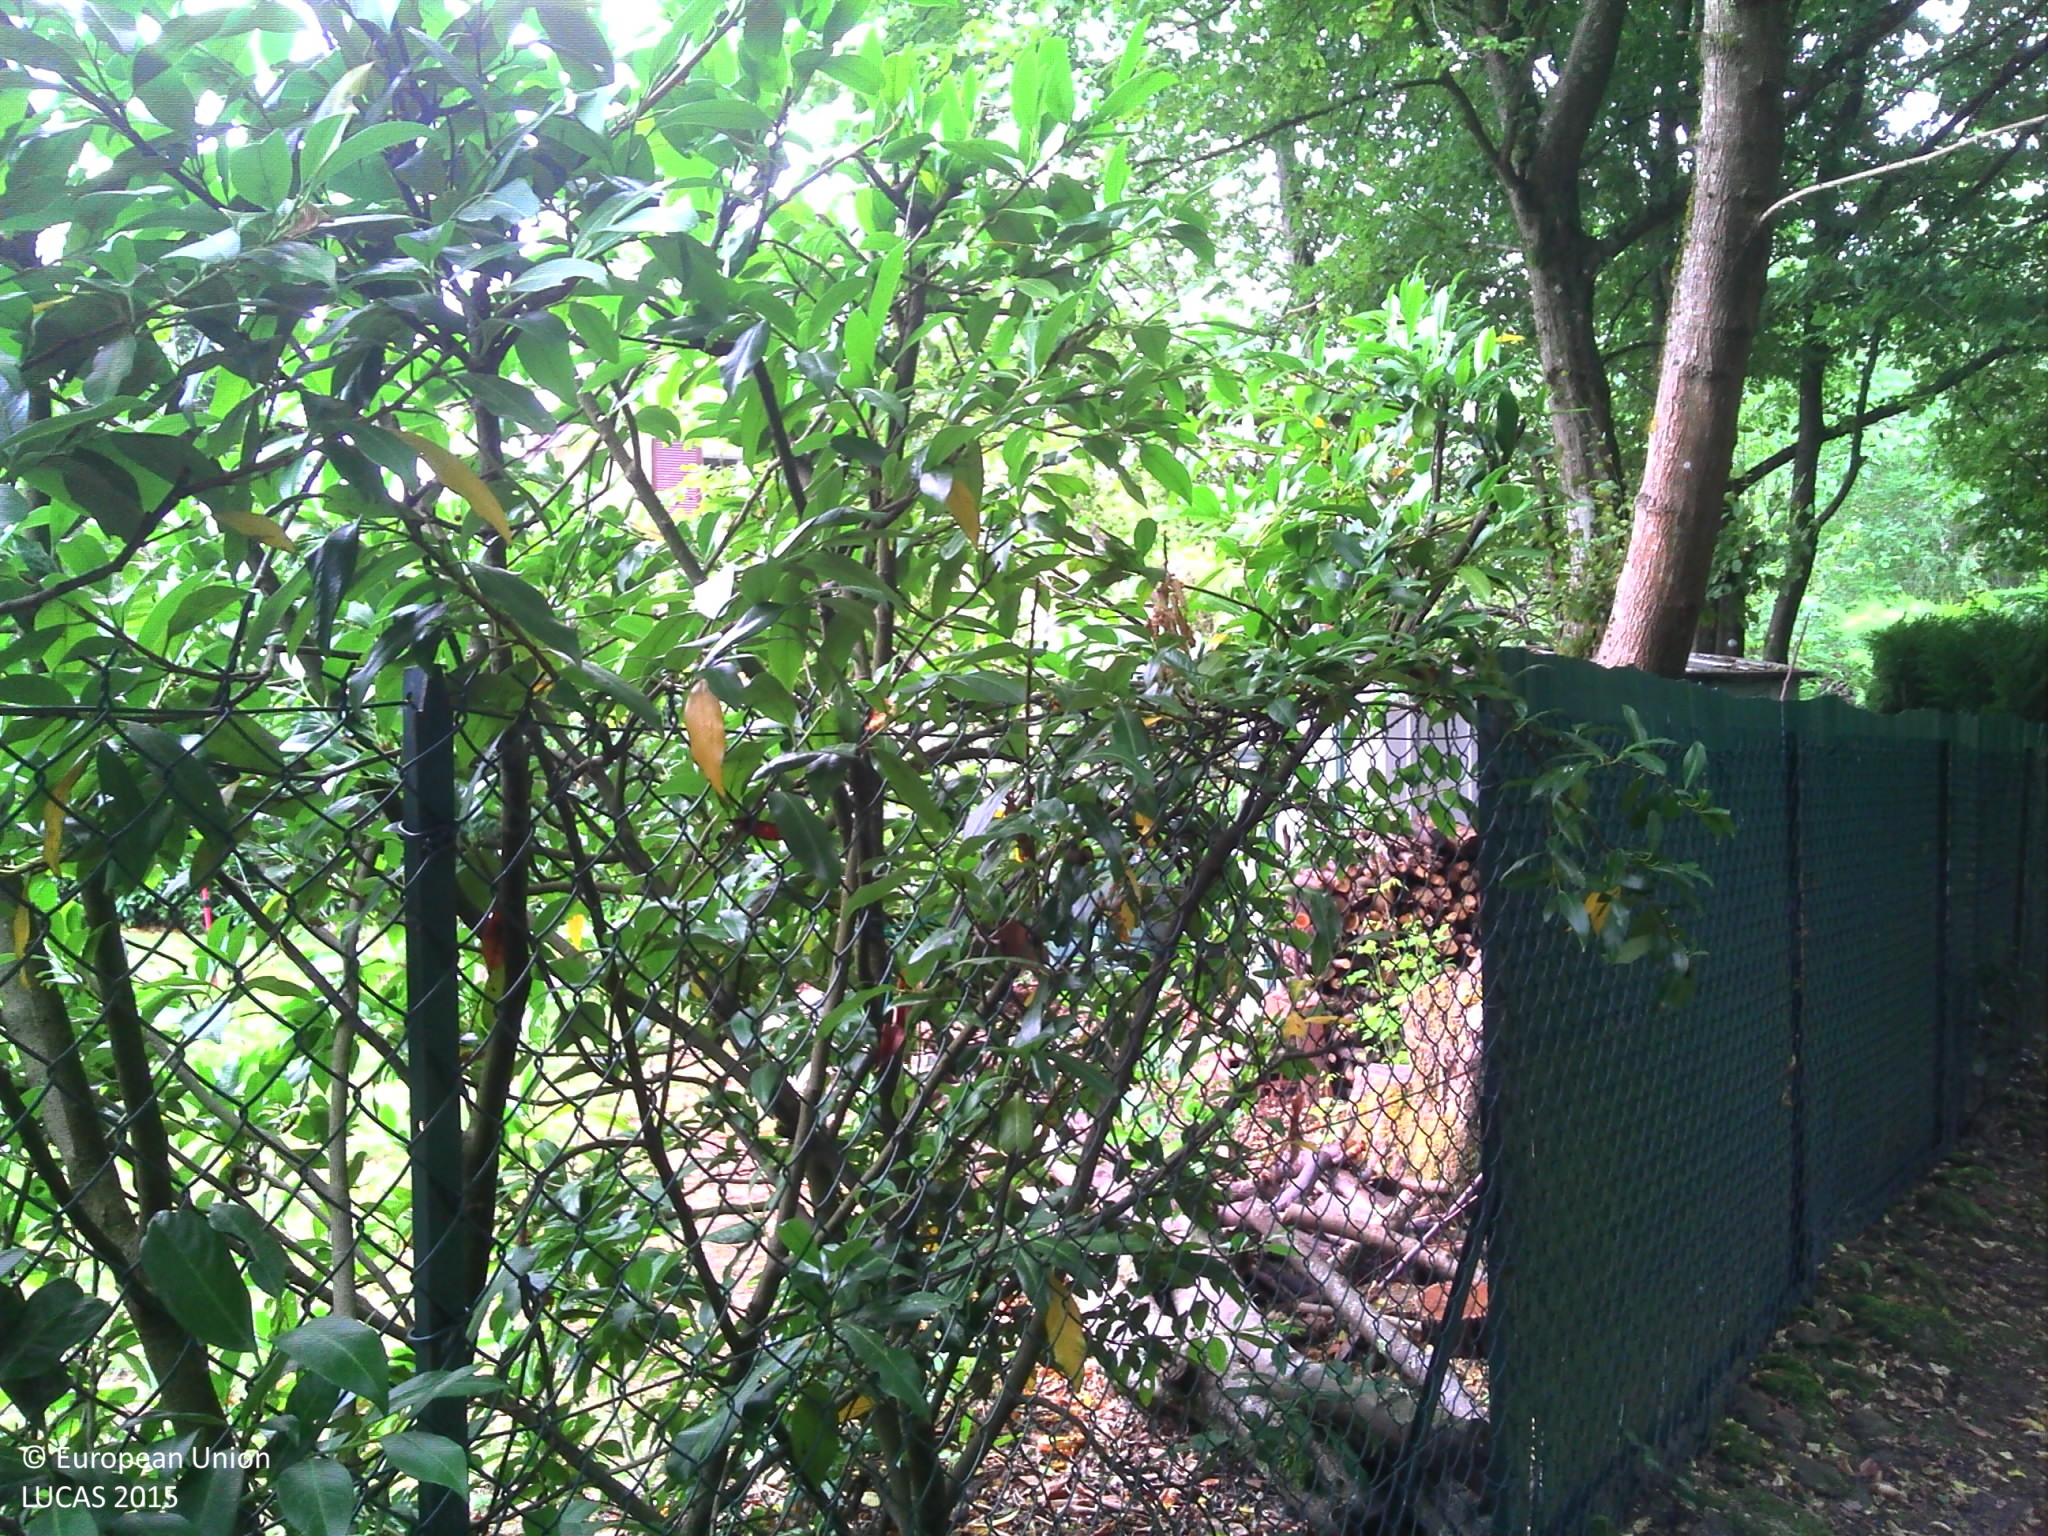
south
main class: Grassland
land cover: Grassland with sparse tree/shrub cover
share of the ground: > 75 %
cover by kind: herbaceous plants 80 %, lichens and mosses 10 %, broadleaved forest trees 5 %, consolidated bare surface 5 %
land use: Residential
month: July
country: FR
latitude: 48.7572
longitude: 2.6852
